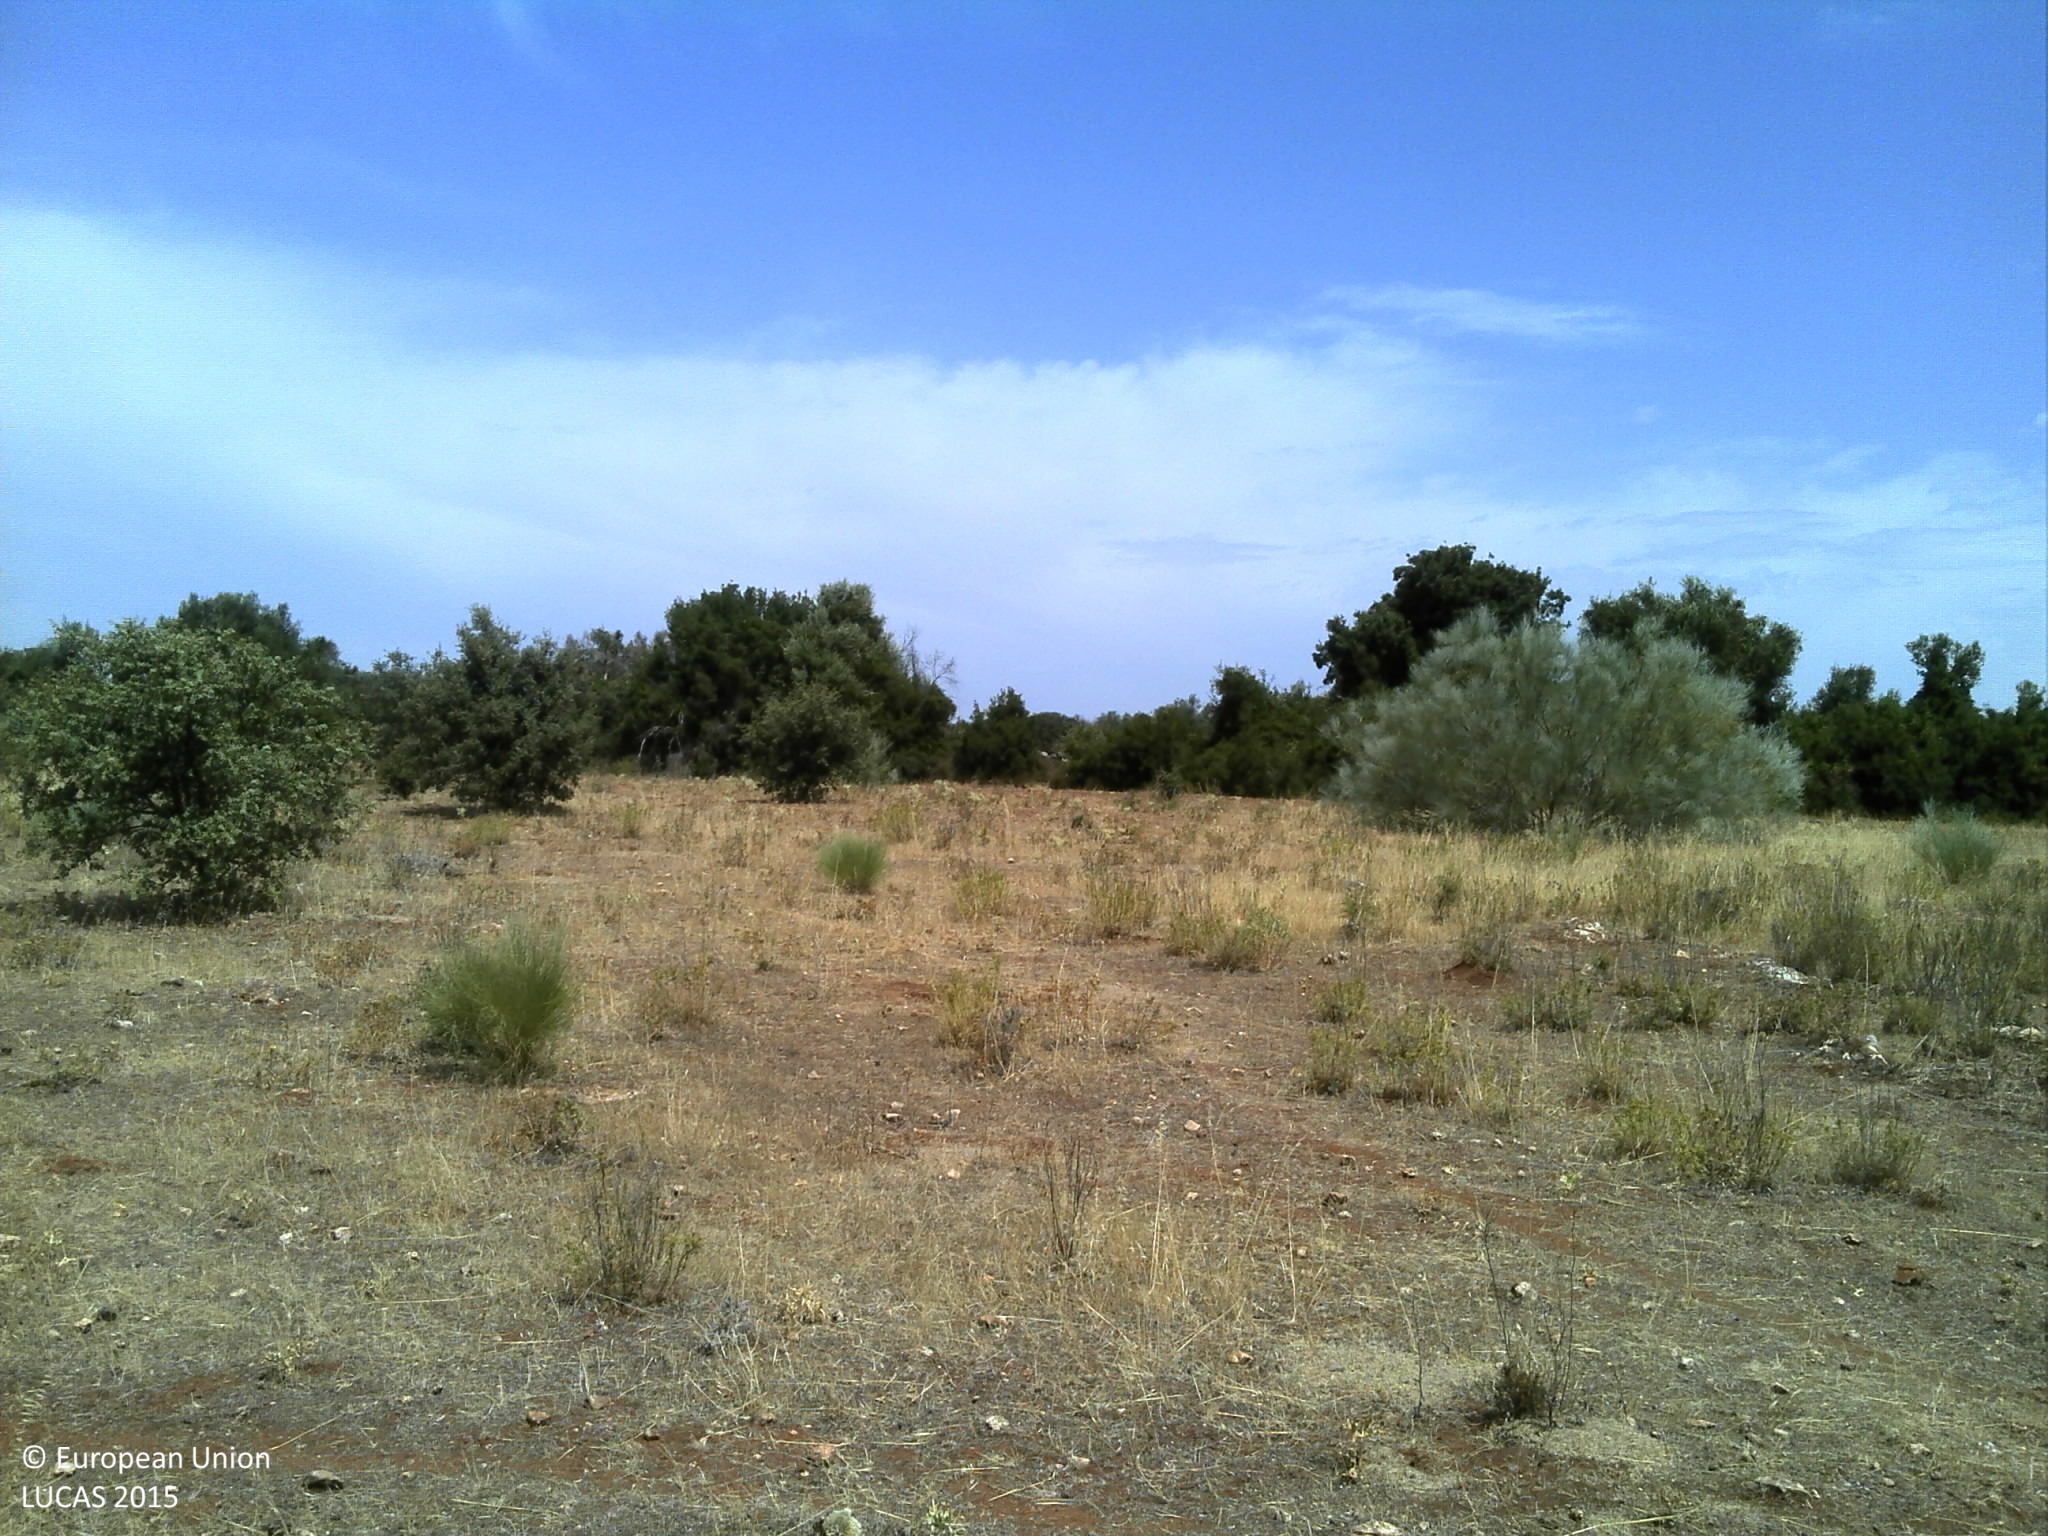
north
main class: Grassland
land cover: Grassland with sparse tree/shrub cover
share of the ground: 25 - 50 %
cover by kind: unconsolidated bare surface 50 %, herbaceous plants 40 %, broadleaved forest trees 5 %, shrubs 5 %
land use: Agriculture (excluding fallow land and kitchen gardens)
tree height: < 5 m
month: July
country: PT
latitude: 38.8360
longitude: -7.5583
